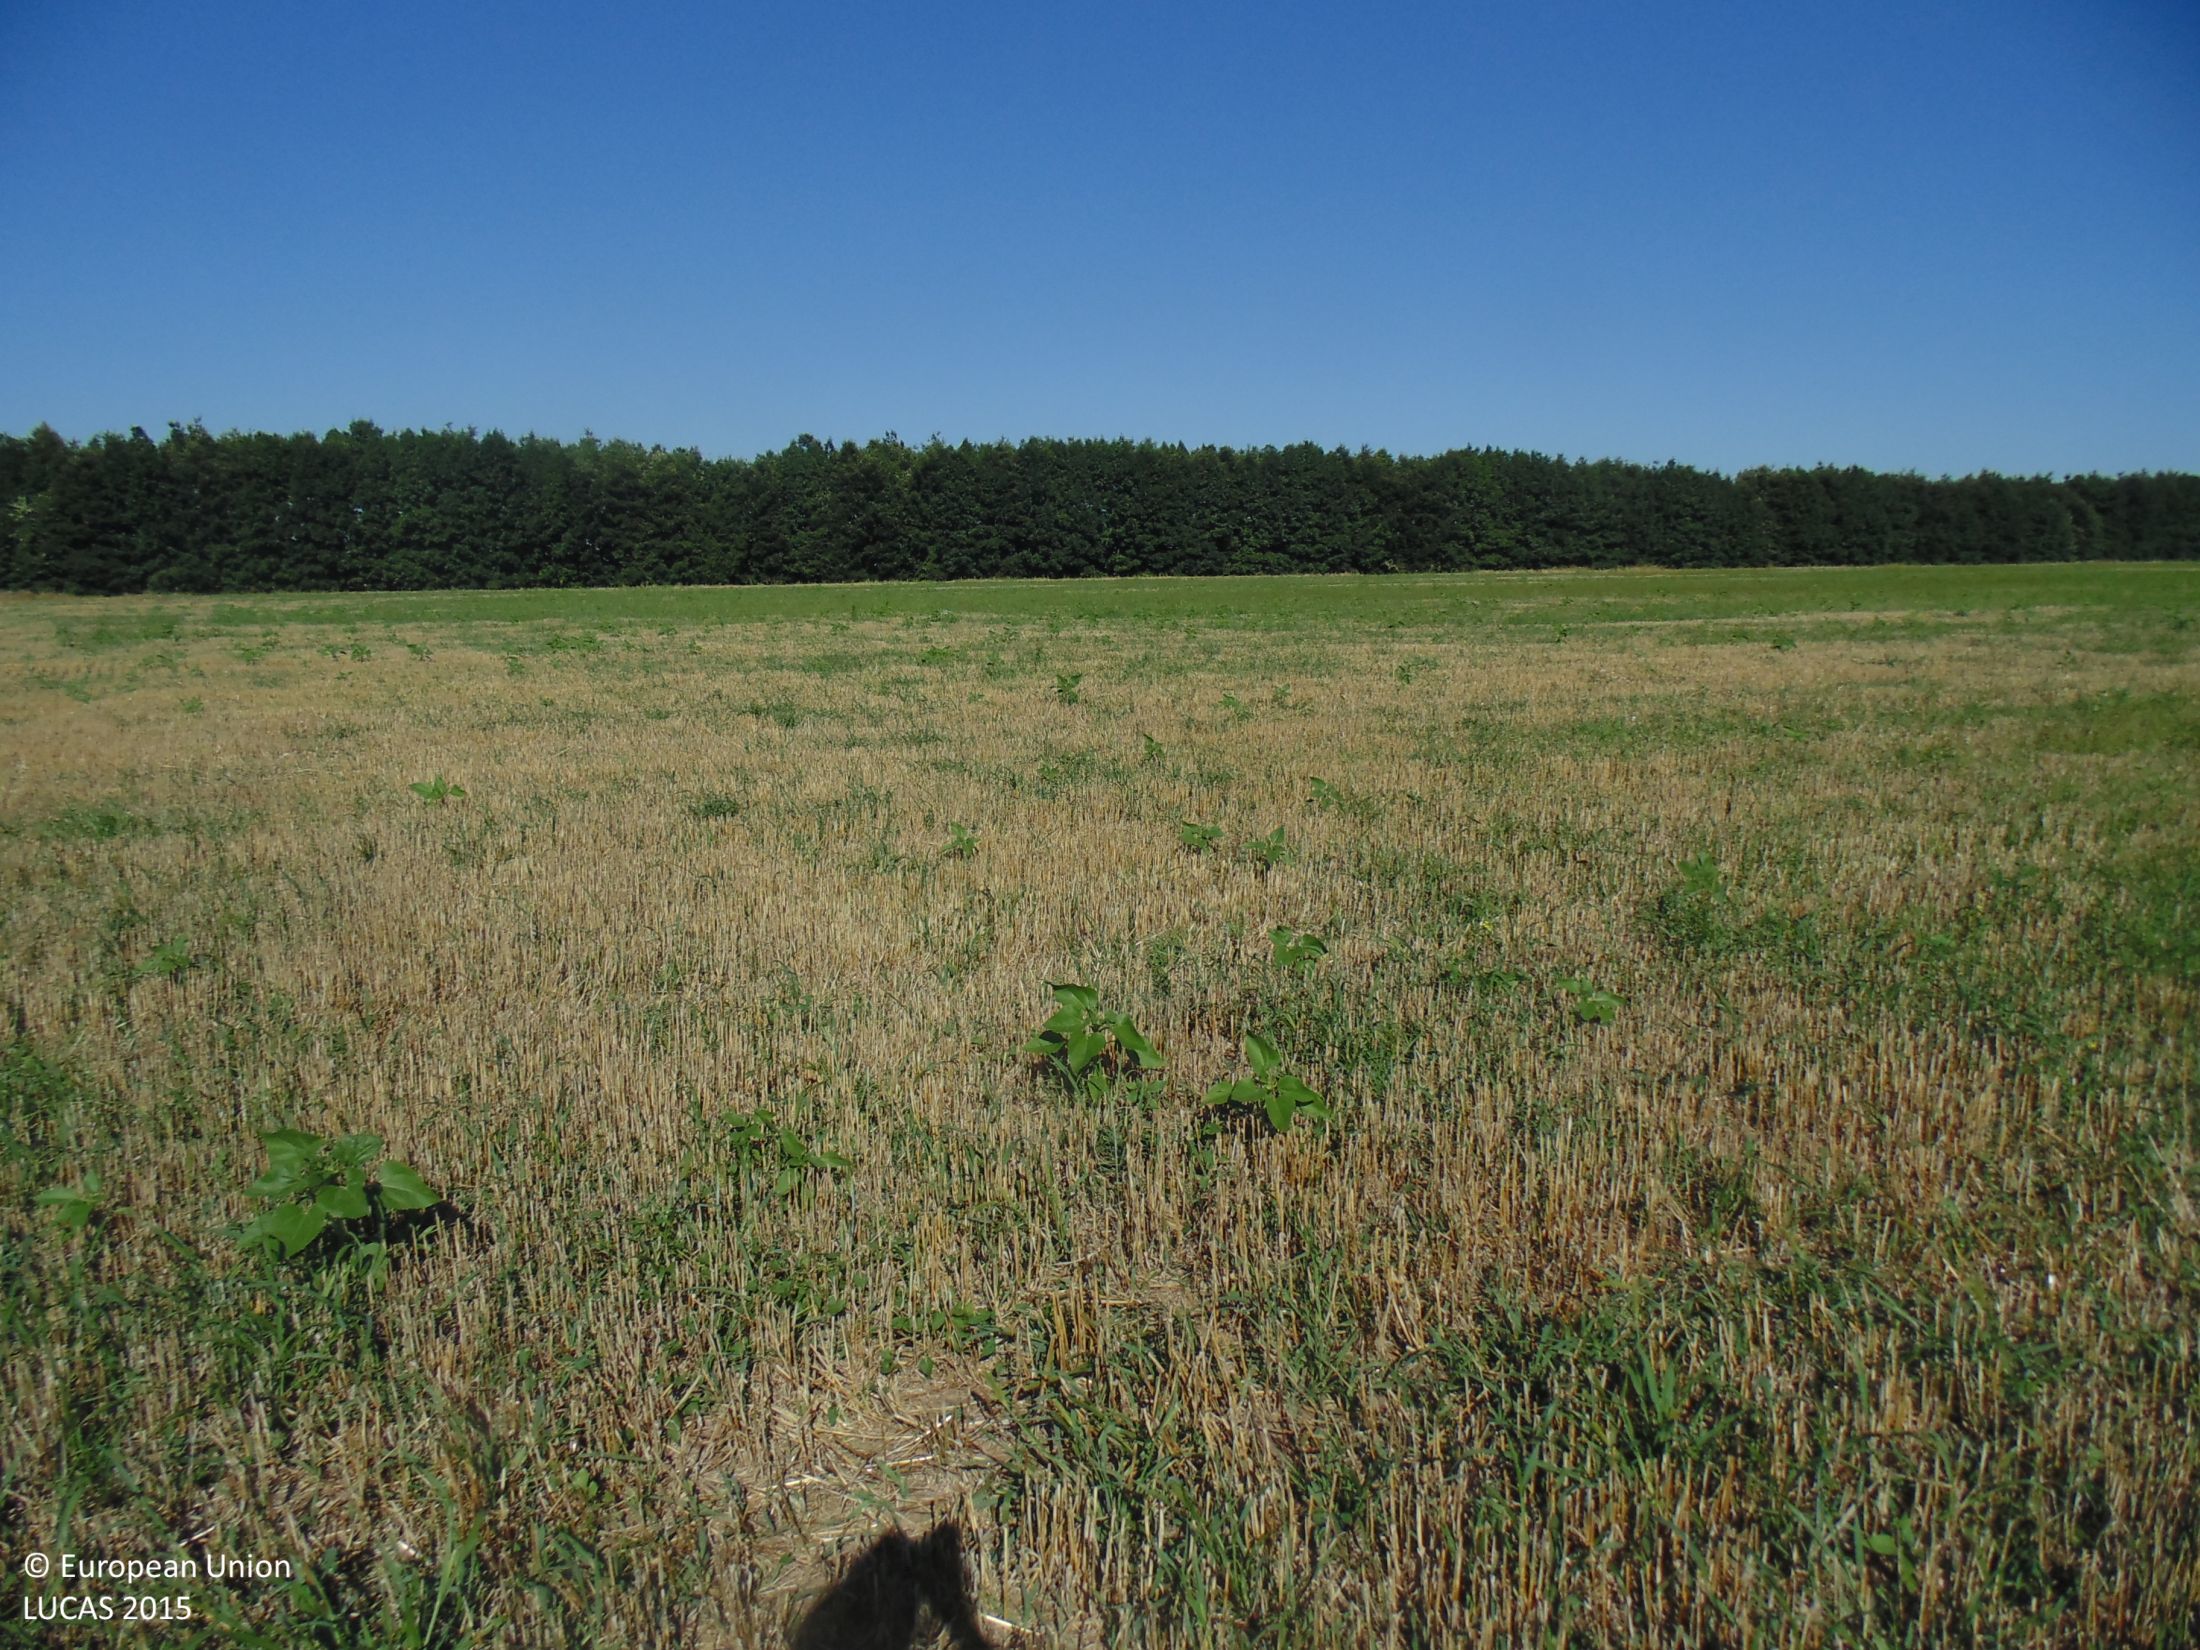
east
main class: Cropland
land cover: Barley
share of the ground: 10 - 25 %
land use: Agriculture (excluding fallow land and kitchen gardens)
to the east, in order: Barley; Grass margins; Broadleaved woodland; Grass margins; Common wheat
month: July
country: BG
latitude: 43.4303
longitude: 28.0714
